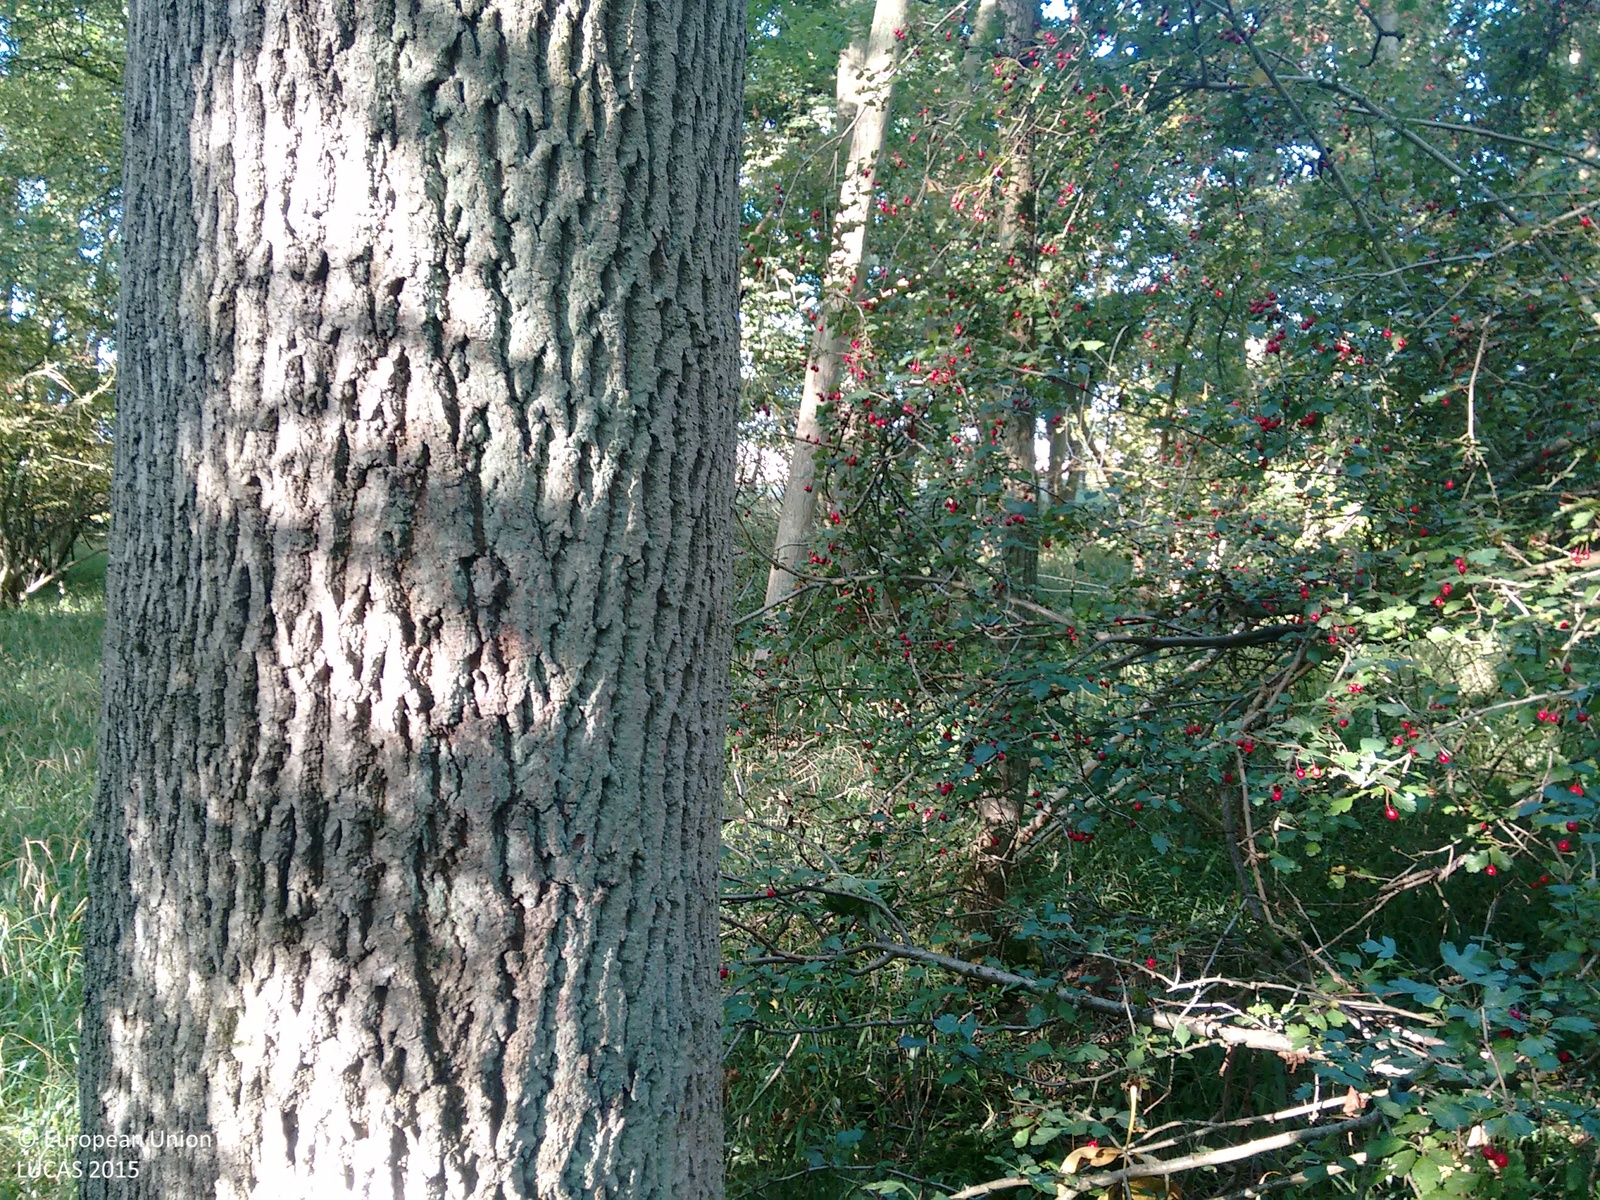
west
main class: Woodland
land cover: Broadleaved woodland
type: mesophytic deciduous forest
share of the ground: > 75 %
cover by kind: broadleaved forest trees 75 %, shrubs 25 %
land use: Amenities, museums, leisure
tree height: > 5 m
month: October
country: GB
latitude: 52.4038
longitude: -0.2509
